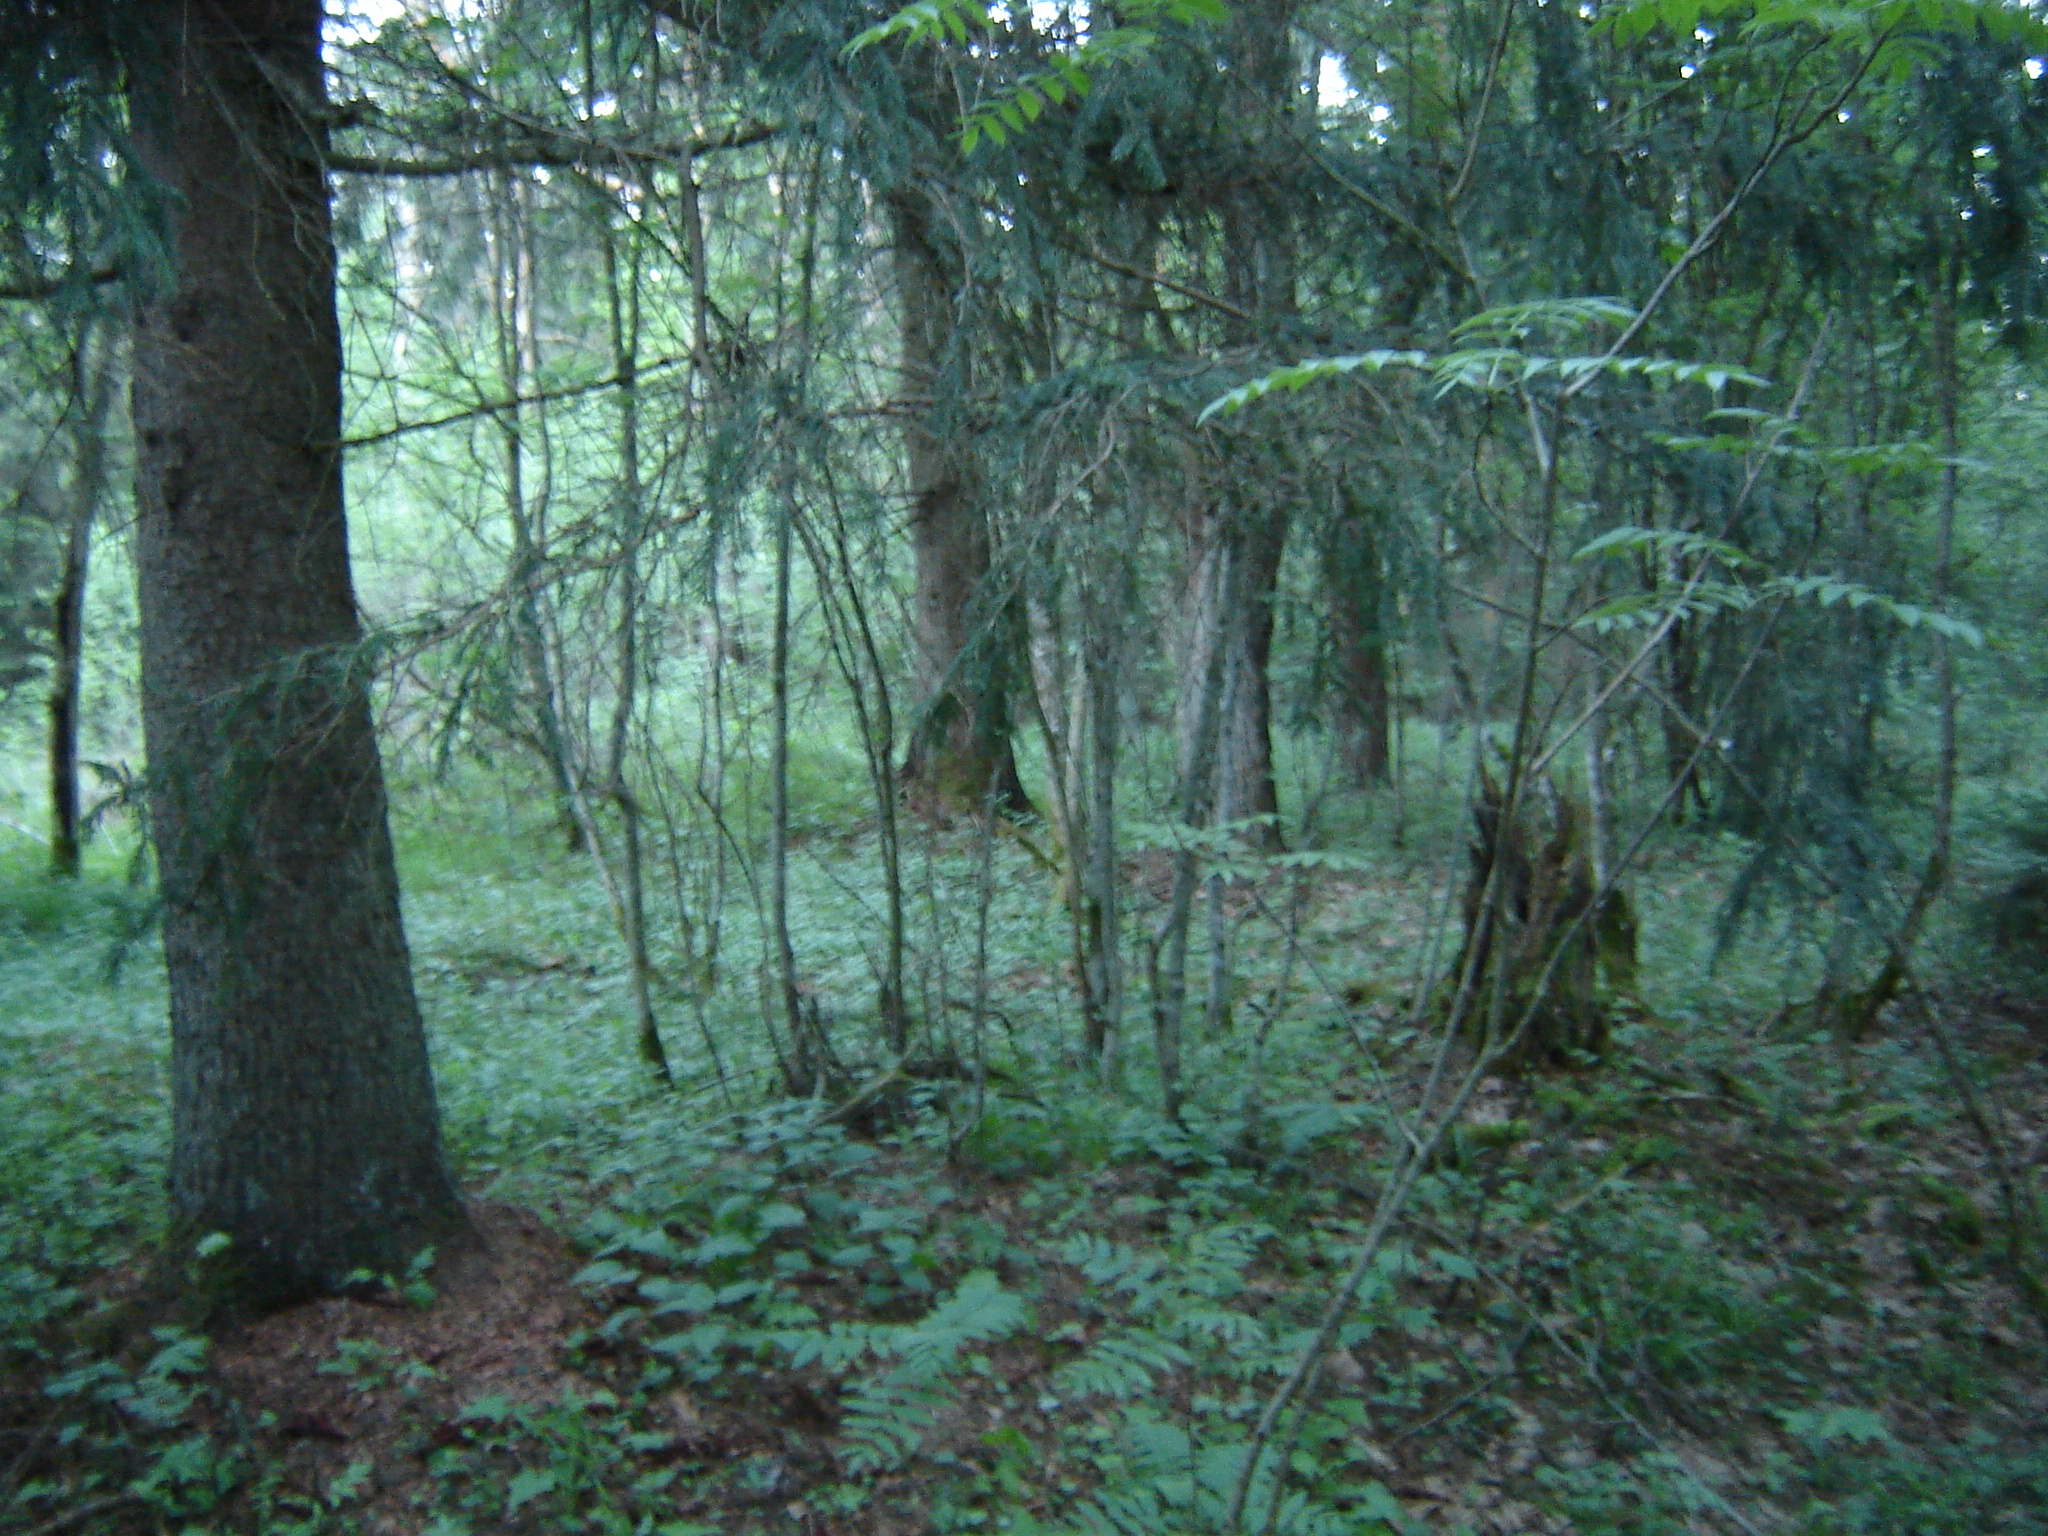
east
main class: Woodland
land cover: Spruce dominated mixed woodland
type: hemiboreal forest and nemoral coniferous forest and mixed broadleaved-coniferous forest
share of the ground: > 75 %
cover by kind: coniferous forest trees 60 %, broadleaved forest trees 40 %
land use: Forestry
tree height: > 5 m
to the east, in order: Spruce dominated mixed woodland; Spruce dominated coniferous woodland; Grass margins; Tracks; Fences; Grassland without tree/shrub cover; Fences; Tracks; Grass margins; Grassland without tree/shrub cover
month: May
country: LT
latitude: 55.7233
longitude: 25.1276
